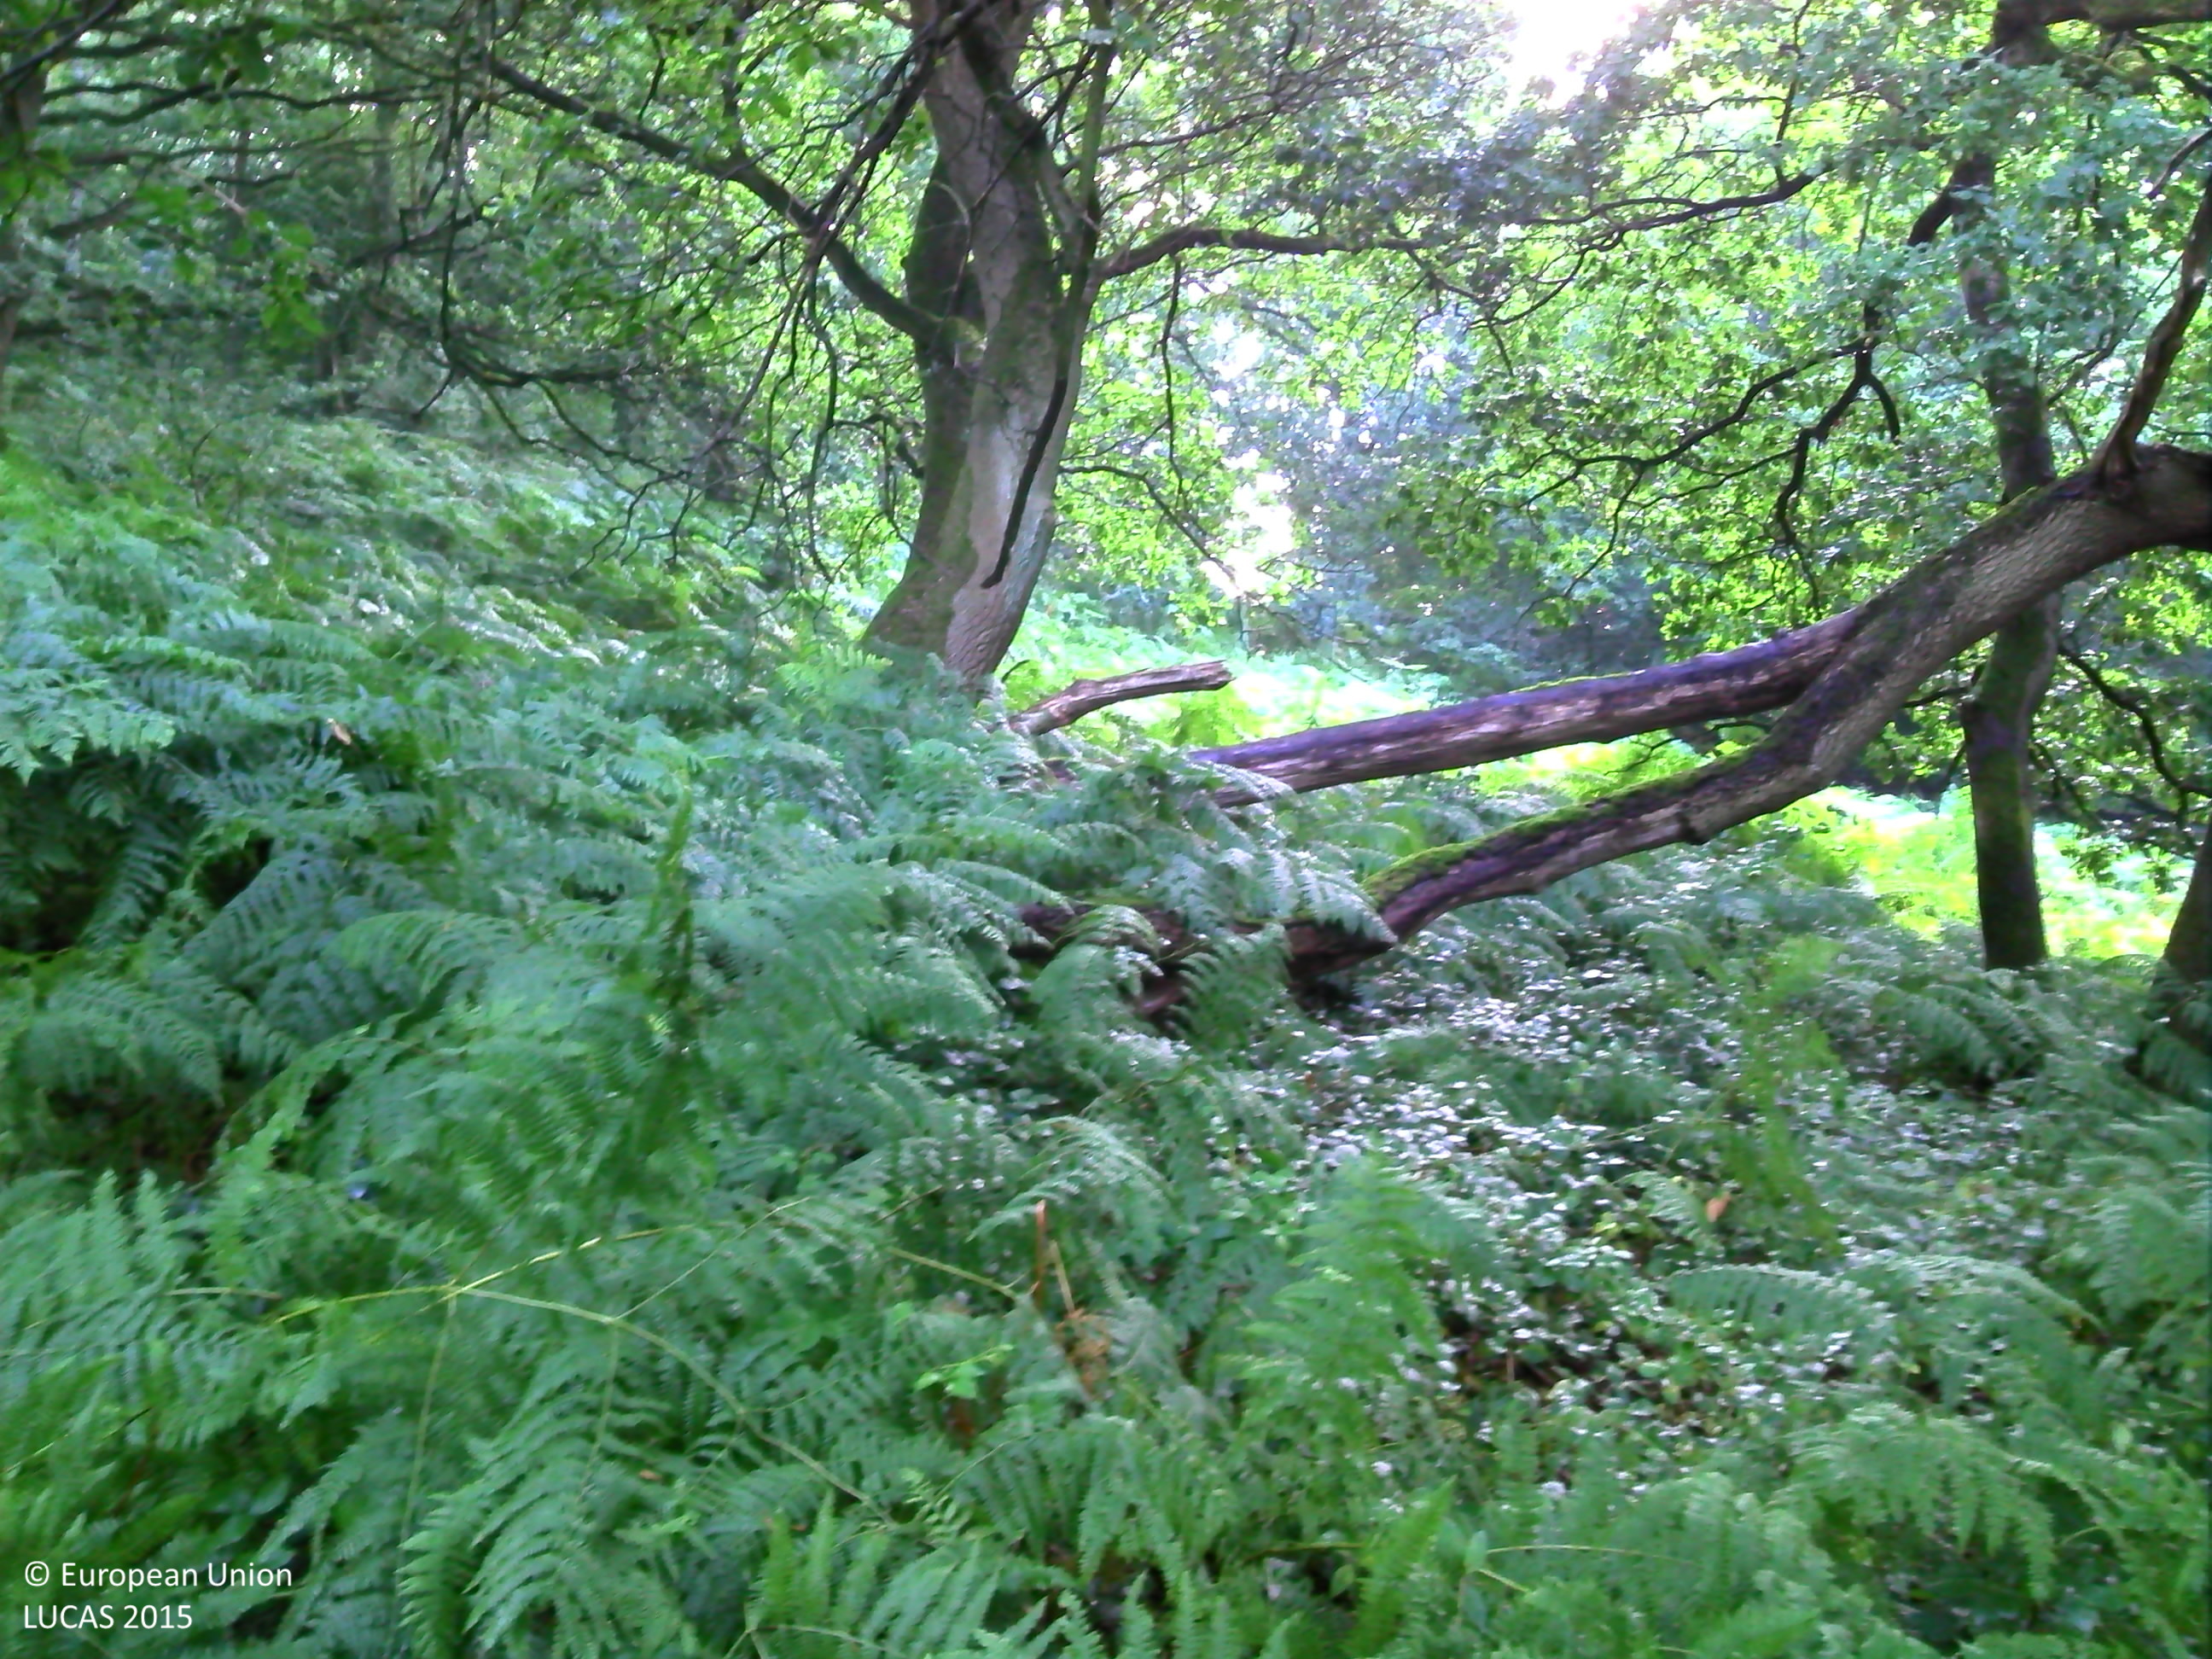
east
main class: Woodland
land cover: Broadleaved woodland
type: mesophytic deciduous forest
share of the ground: > 75 %
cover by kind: broadleaved forest trees 70 %, herbaceous plants 30 %
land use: Forestry
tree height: > 5 m
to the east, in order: Broadleaved woodland; Paved roads, cycling and walking lanes; Grass margins; Fences; Grassland without tree/shrub cover; Apple fruit; Grassland without tree/shrub cover; Fences; Grassland without tree/shrub cover
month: August
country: BE
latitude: 50.6639
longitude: 5.7685
